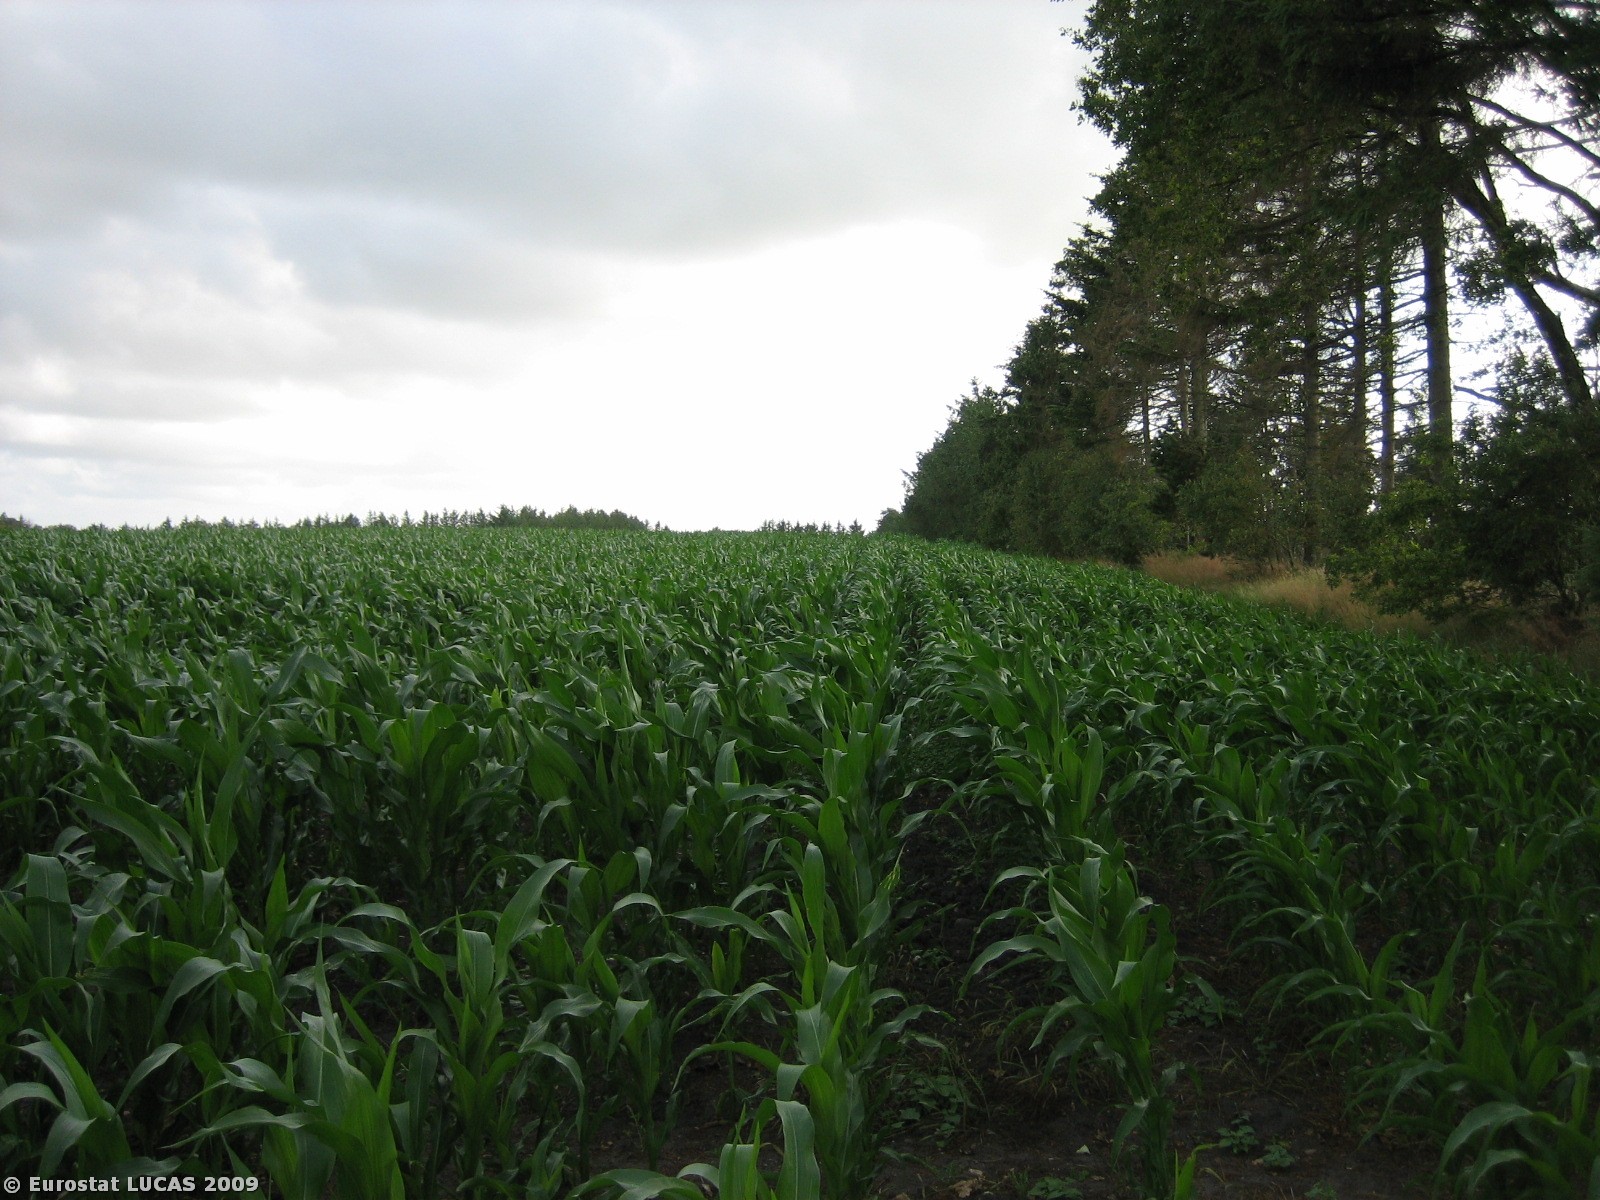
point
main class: Cropland
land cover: Barley
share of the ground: 25 - 50 %
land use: Agriculture (excluding fallow land and kitchen gardens)
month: July
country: DK
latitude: 55.7107
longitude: 8.4258
